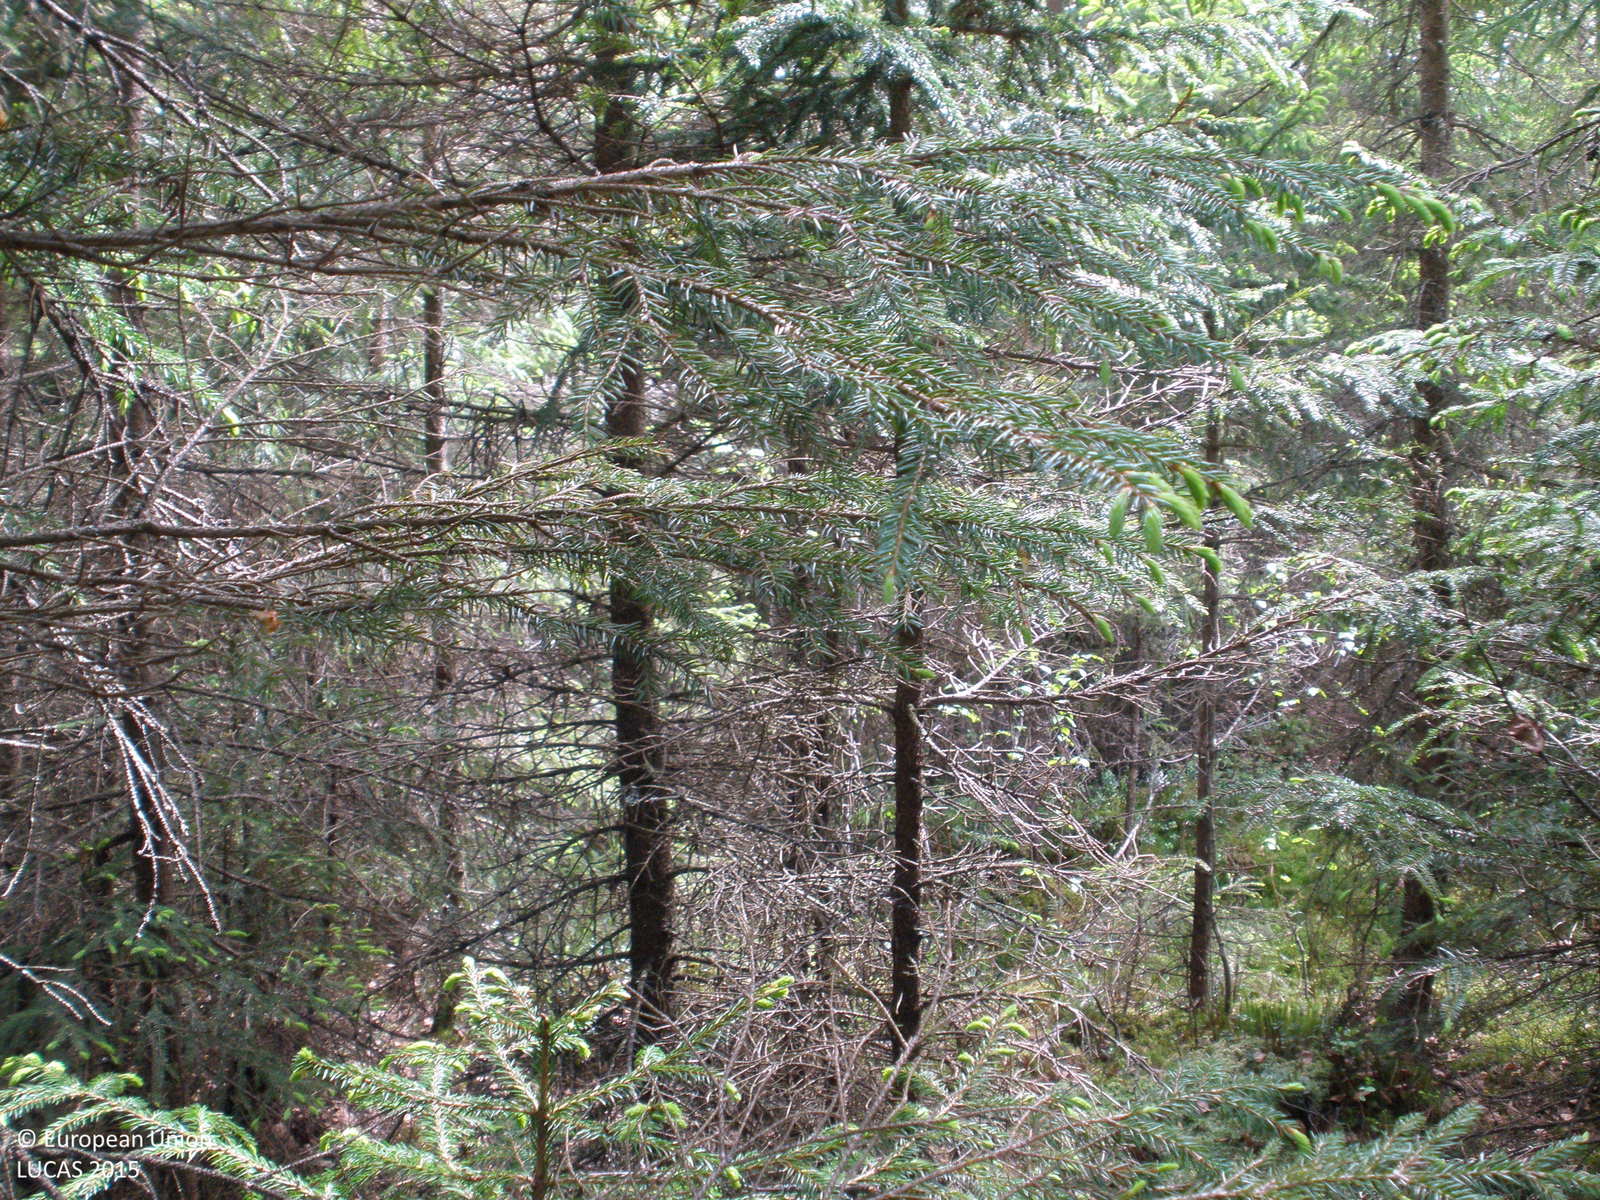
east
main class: Woodland
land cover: Spruce dominated mixed woodland
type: boreal forest
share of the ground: > 75 %
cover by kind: coniferous forest trees 60 %, broadleaved forest trees 25 %, herbaceous plants 10 %, lichens and mosses 5 %
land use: Forestry
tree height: > 5 m
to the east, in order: Spruce dominated mixed woodland; Other mixed woodland; Ditches and canals; Other mixed woodland; Ditches and canals; Spruce dominated mixed woodland
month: June
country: FI
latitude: 60.8569
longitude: 24.1417
